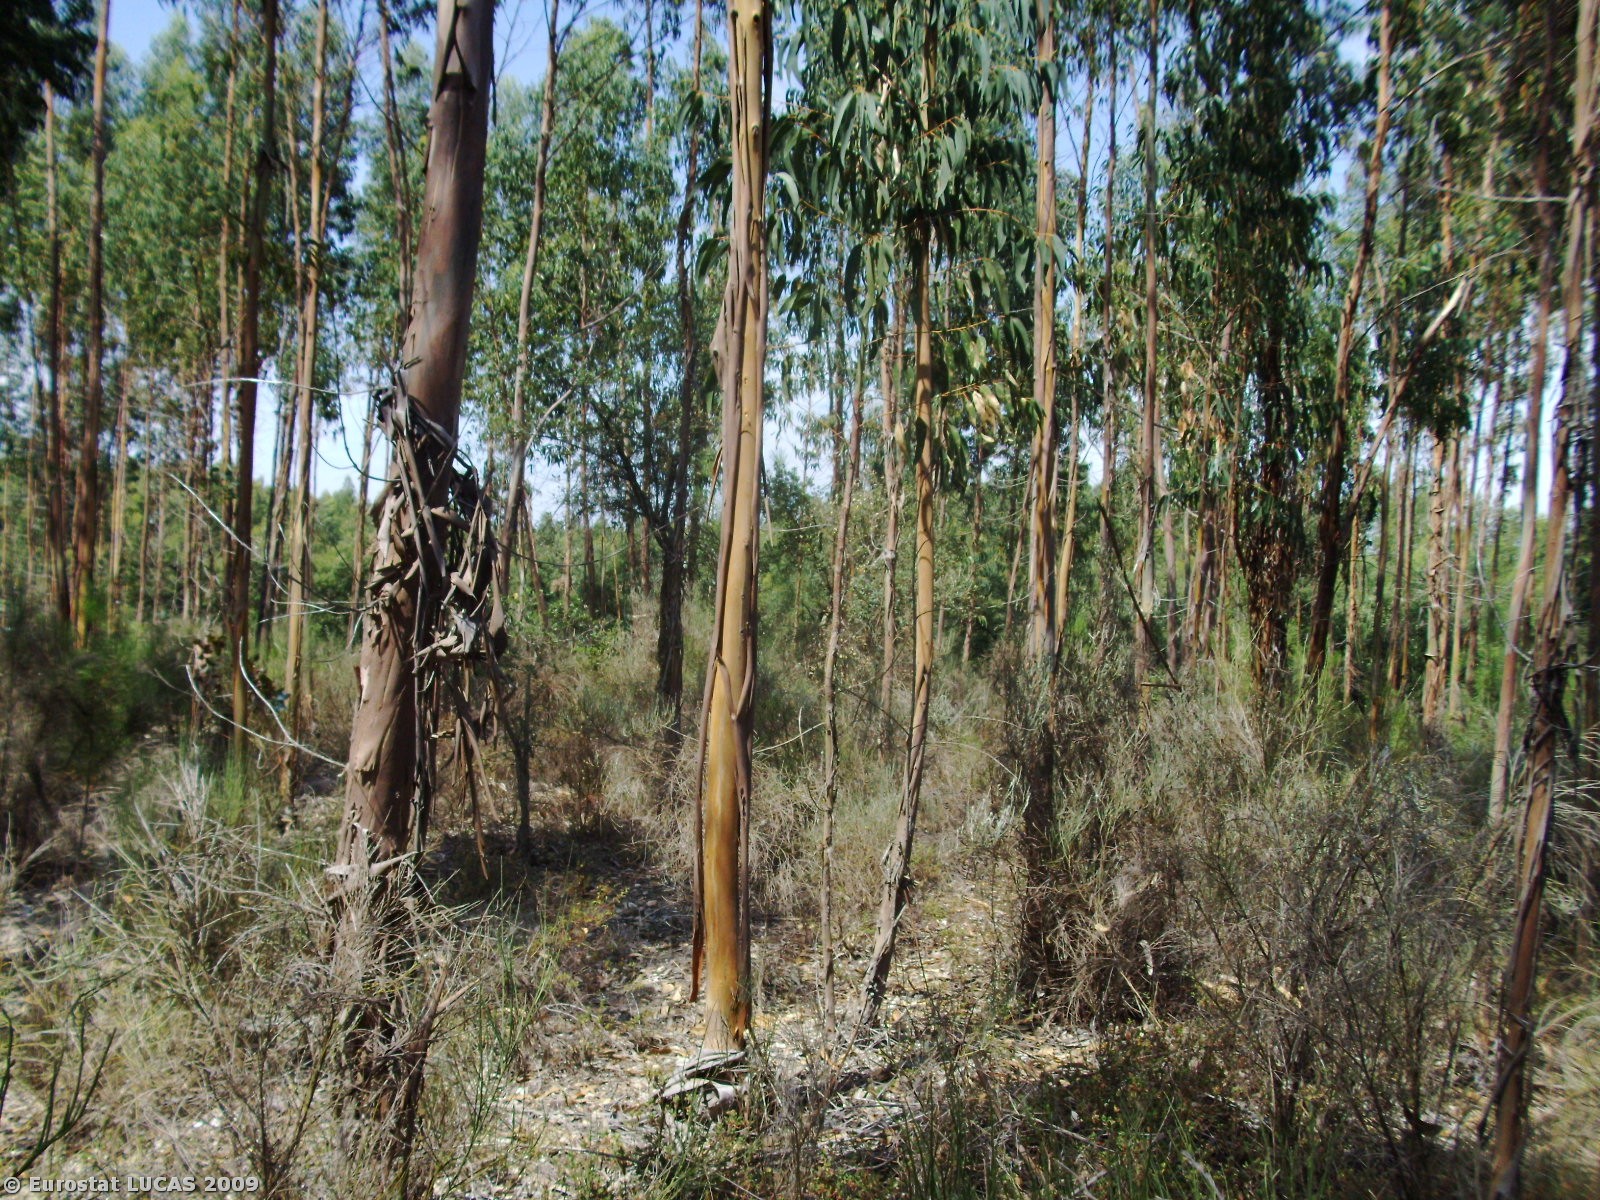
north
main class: Woodland
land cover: Broadleaved woodland
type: plantations and self-sown exotic forest
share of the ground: 50 - 75 %
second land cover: Spontaneously vegetated surfaces
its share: 10 - 25 %
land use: Forestry
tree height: > 5 m
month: August
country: PT
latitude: 39.2828
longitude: -8.1321
